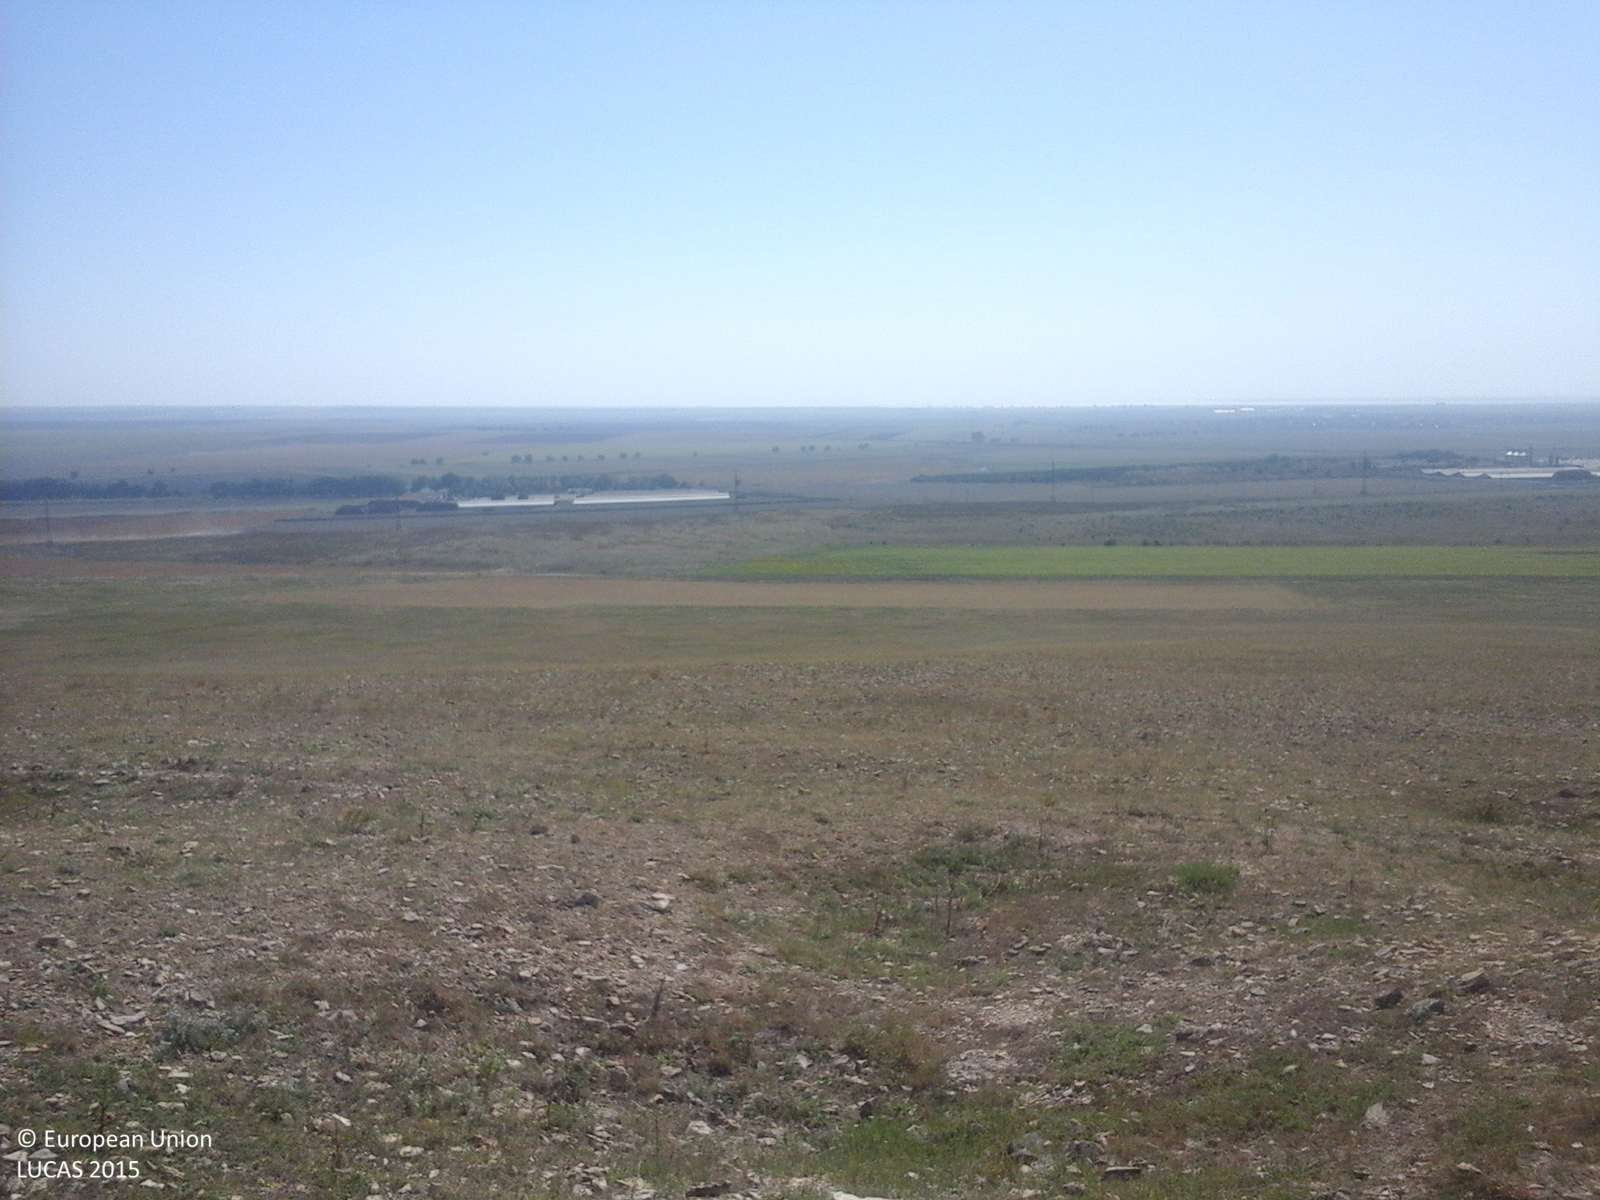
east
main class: Grassland
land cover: Grassland without tree/shrub cover
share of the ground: 50 - 75 %
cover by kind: herbaceous plants 65 %, consolidated bare surface 35 %
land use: Agriculture (excluding fallow land and kitchen gardens)
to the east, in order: Grassland without tree/shrub cover
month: August
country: RO
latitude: 44.7628
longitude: 28.6657
